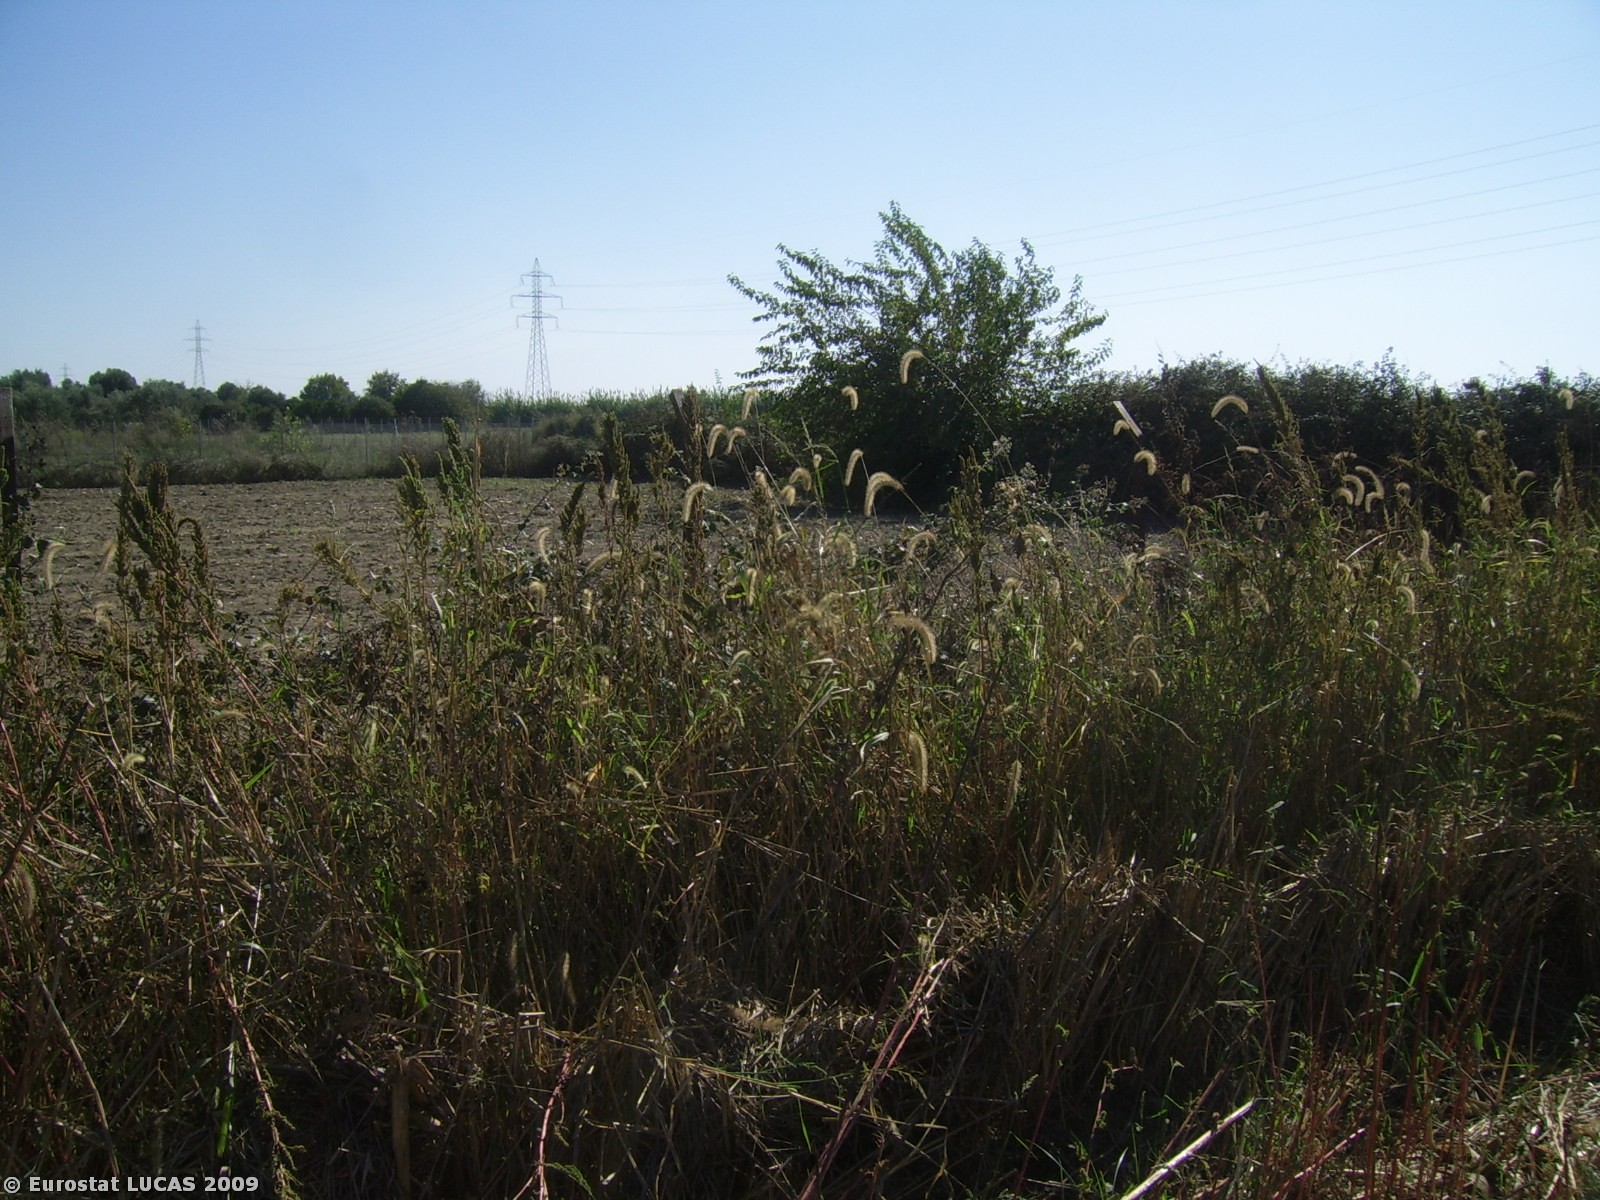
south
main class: Cropland
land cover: Maize
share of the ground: < 10 %
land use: Agriculture (excluding fallow land and kitchen gardens)
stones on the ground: < 10 %
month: October
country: GR
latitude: 37.8207
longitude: 21.3088
